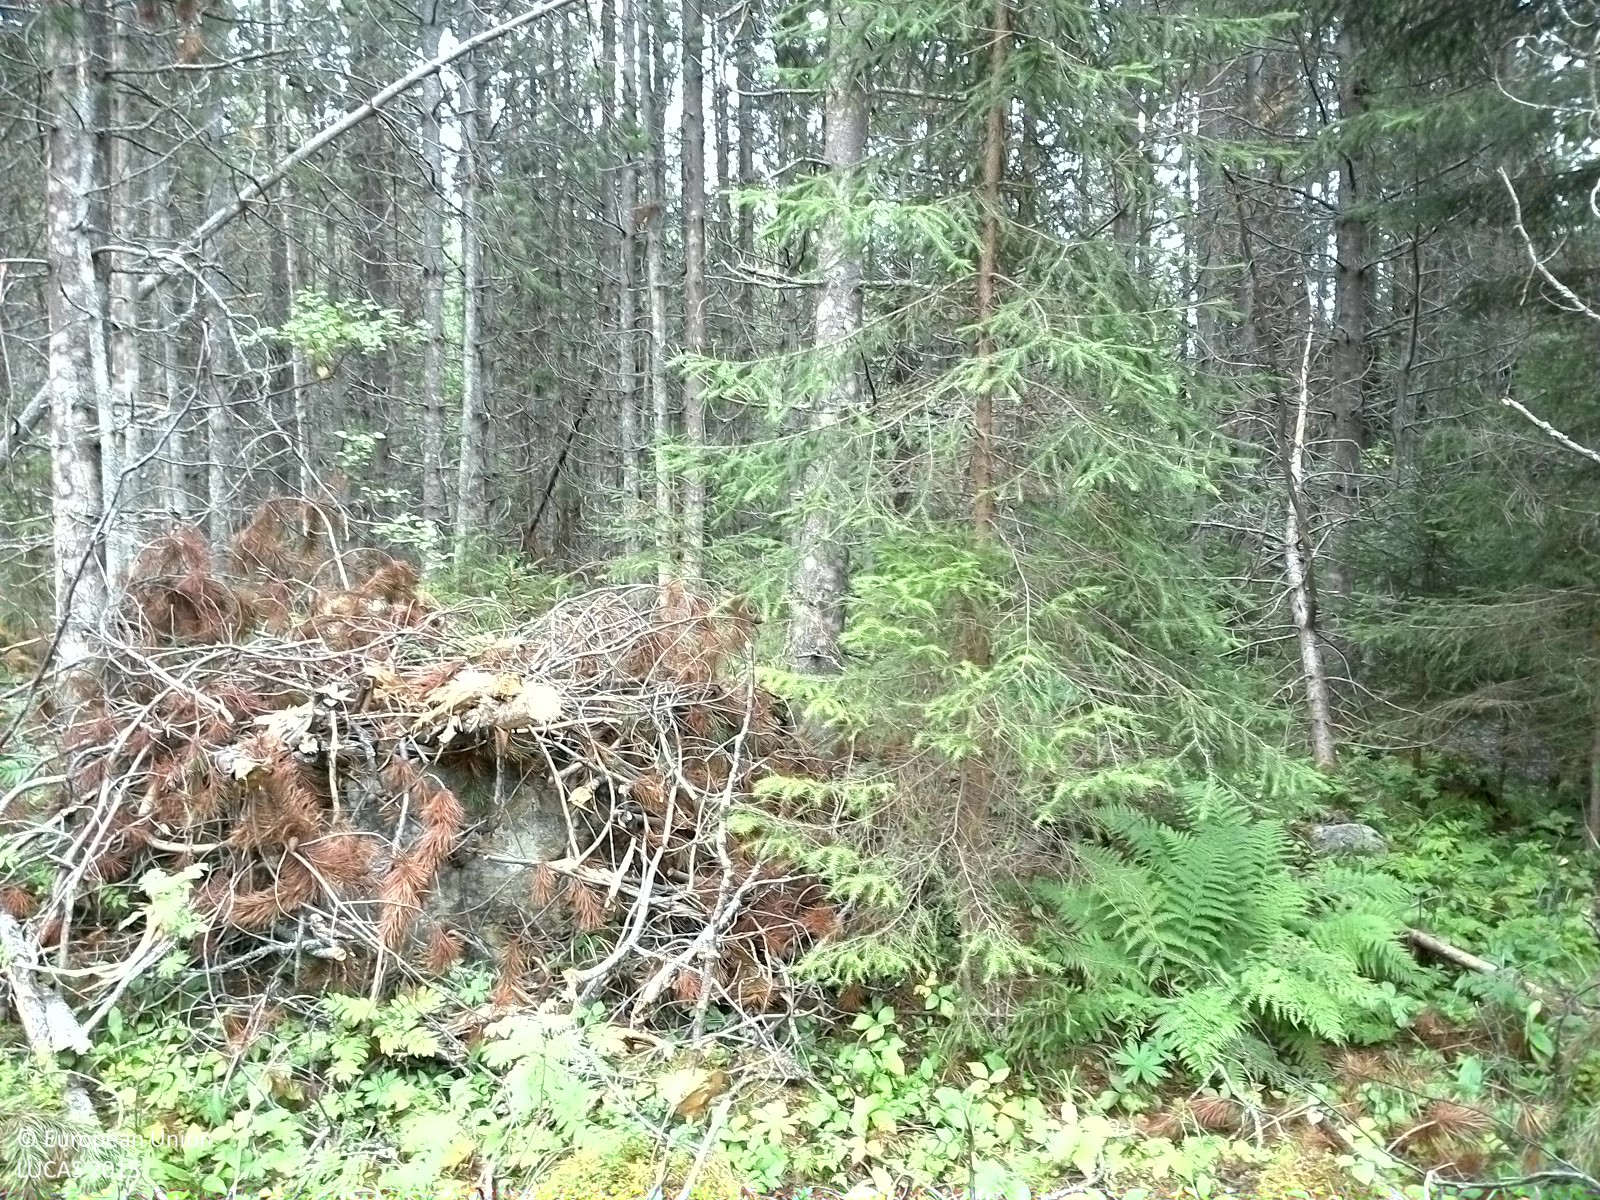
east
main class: Woodland
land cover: Pine dominated coniferous woodland
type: exotic forest
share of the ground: 50 - 75 %
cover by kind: coniferous forest trees 60 %, herbaceous plants 30 %, lichens and mosses 10 %
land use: Forestry
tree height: > 5 m
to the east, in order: Pine dominated coniferous woodland; Tracks; Pine dominated coniferous woodland; Ditches and canals; Pine dominated coniferous woodland; Ditches and canals; Pine dominated coniferous woodland; Ditches and canals; Pine dominated coniferous woodland; Ditches and canals; Pine dominated coniferous woodland; Ditches and canals; Pine dominated coniferous woodland
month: August
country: SE
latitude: 62.2105
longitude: 16.2677
